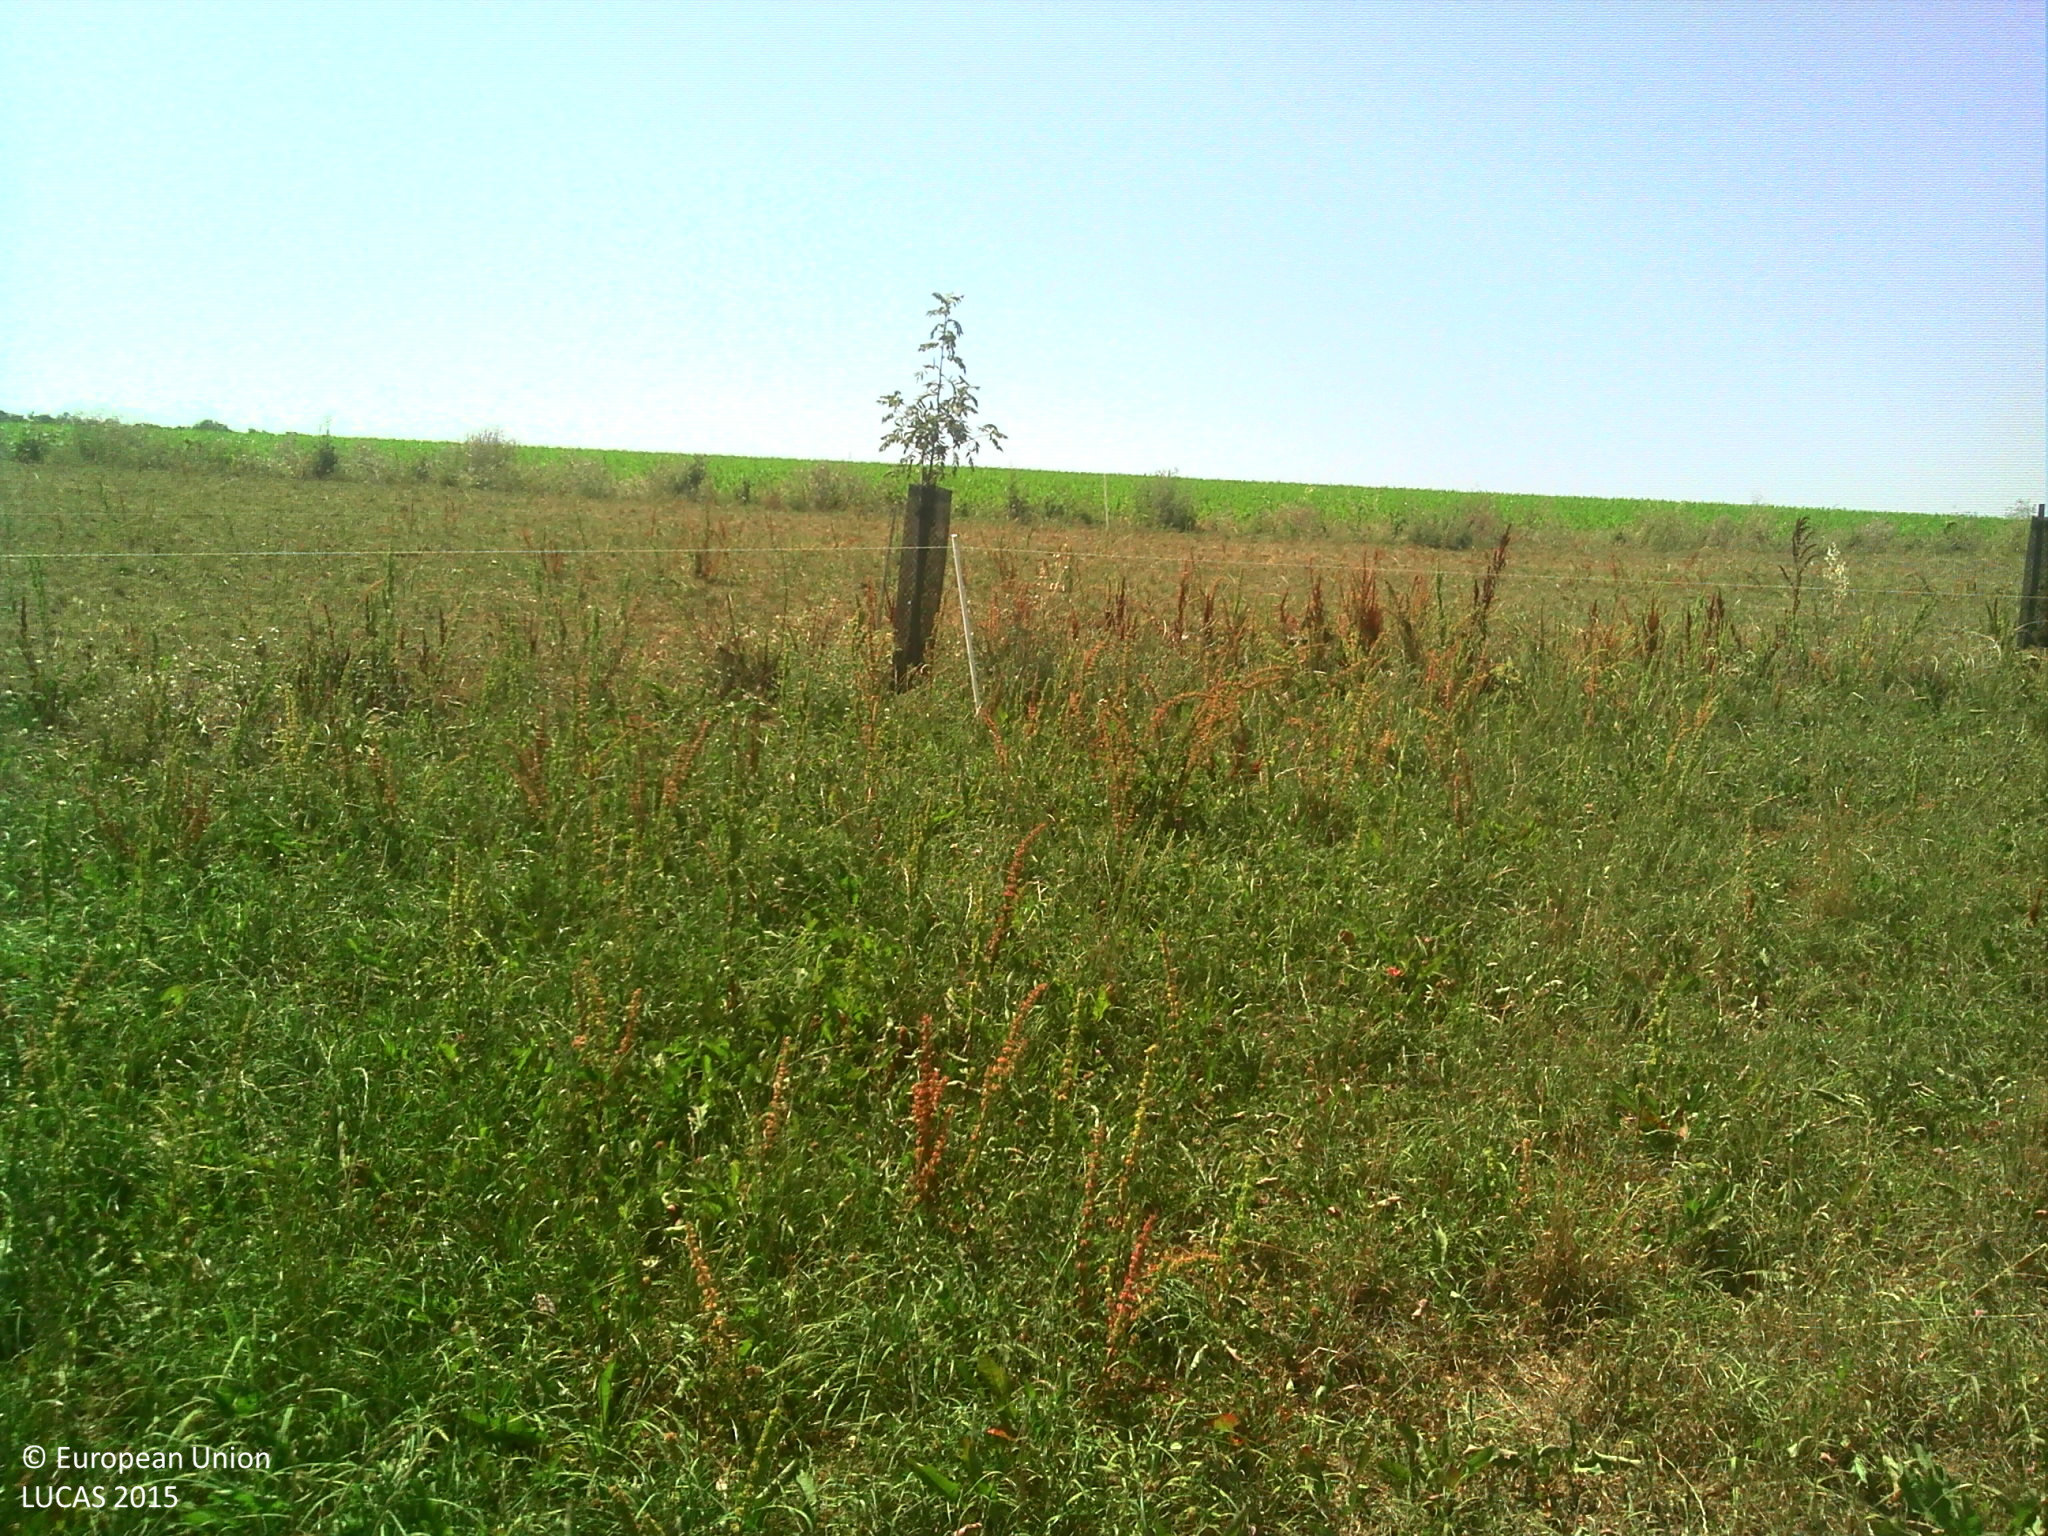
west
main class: Grassland
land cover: Grassland without tree/shrub cover
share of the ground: > 75 %
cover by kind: herbaceous plants 100 %
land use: Agriculture (excluding fallow land and kitchen gardens)
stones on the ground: 10 - 25 %
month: July
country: FR
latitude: 44.0115
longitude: 0.9798
